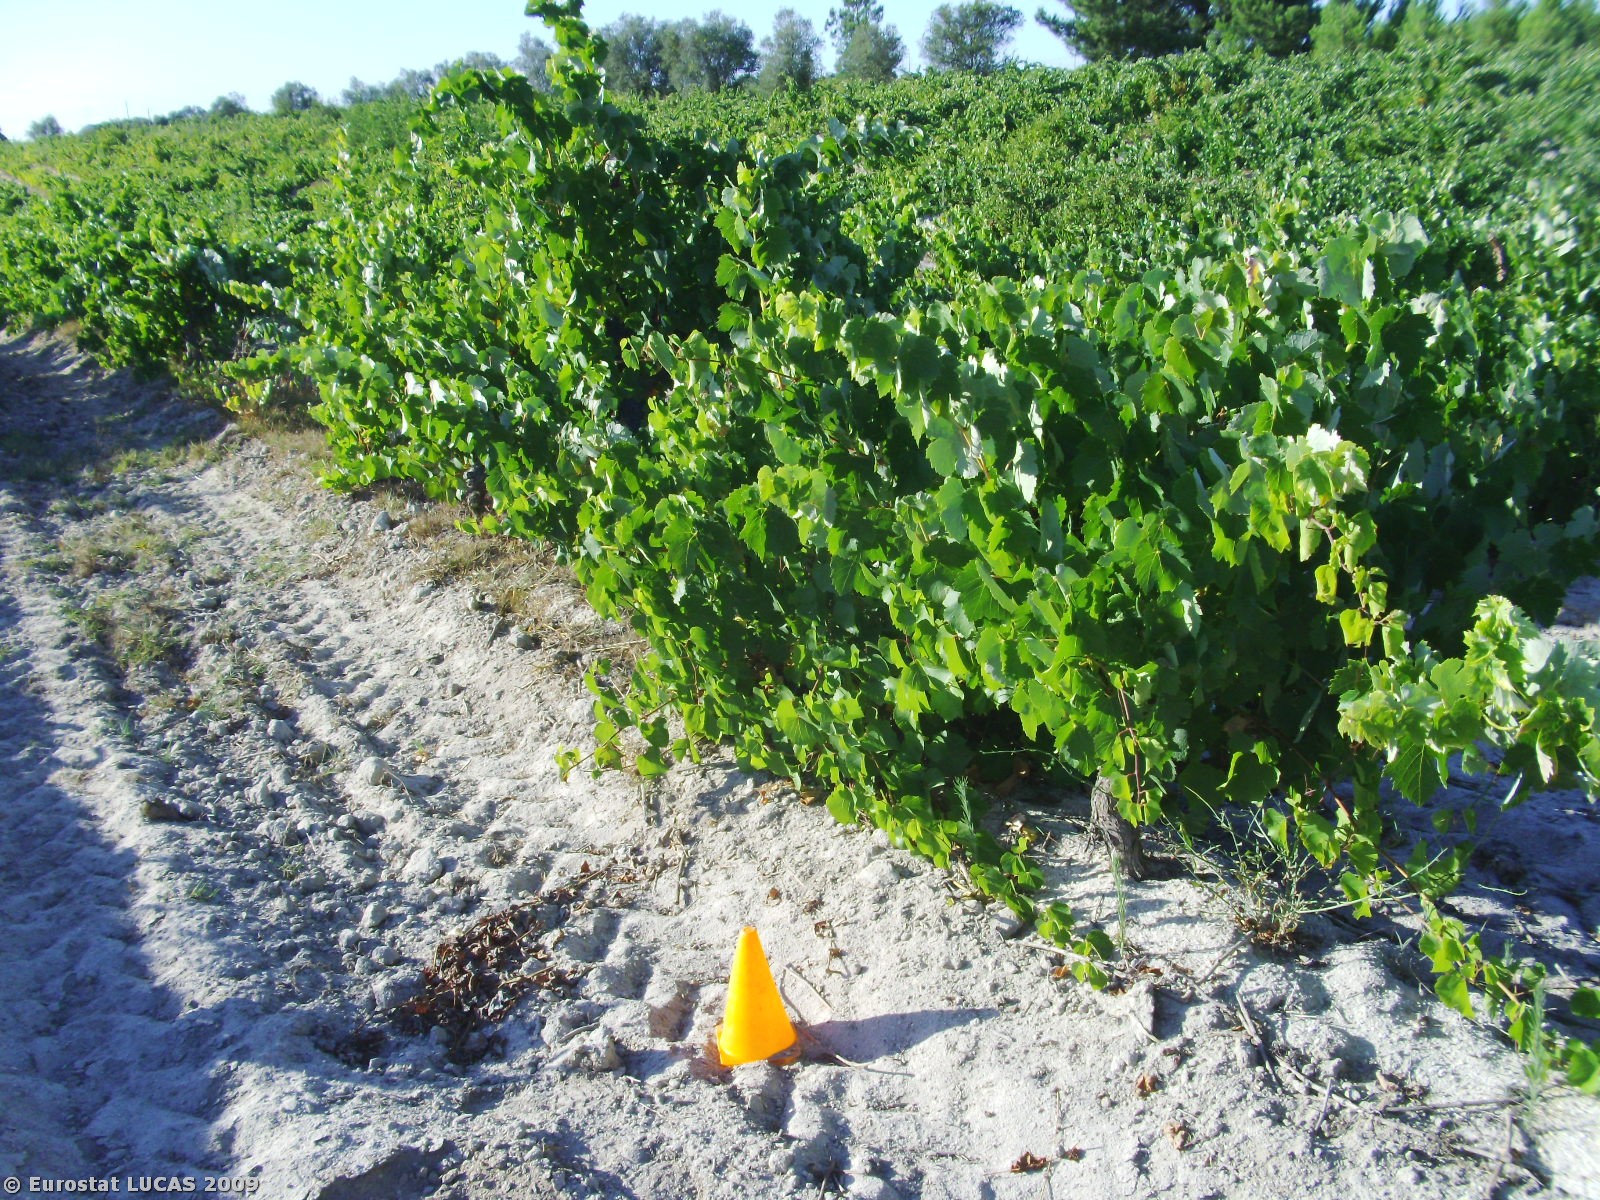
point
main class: Cropland
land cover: Vineyards
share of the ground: 25 - 50 %
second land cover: Bare land
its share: 25 - 50 %
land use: Agriculture (excluding fallow land and kitchen gardens)
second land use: Fallow land
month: August
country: PT
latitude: 38.6220
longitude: -8.6788
